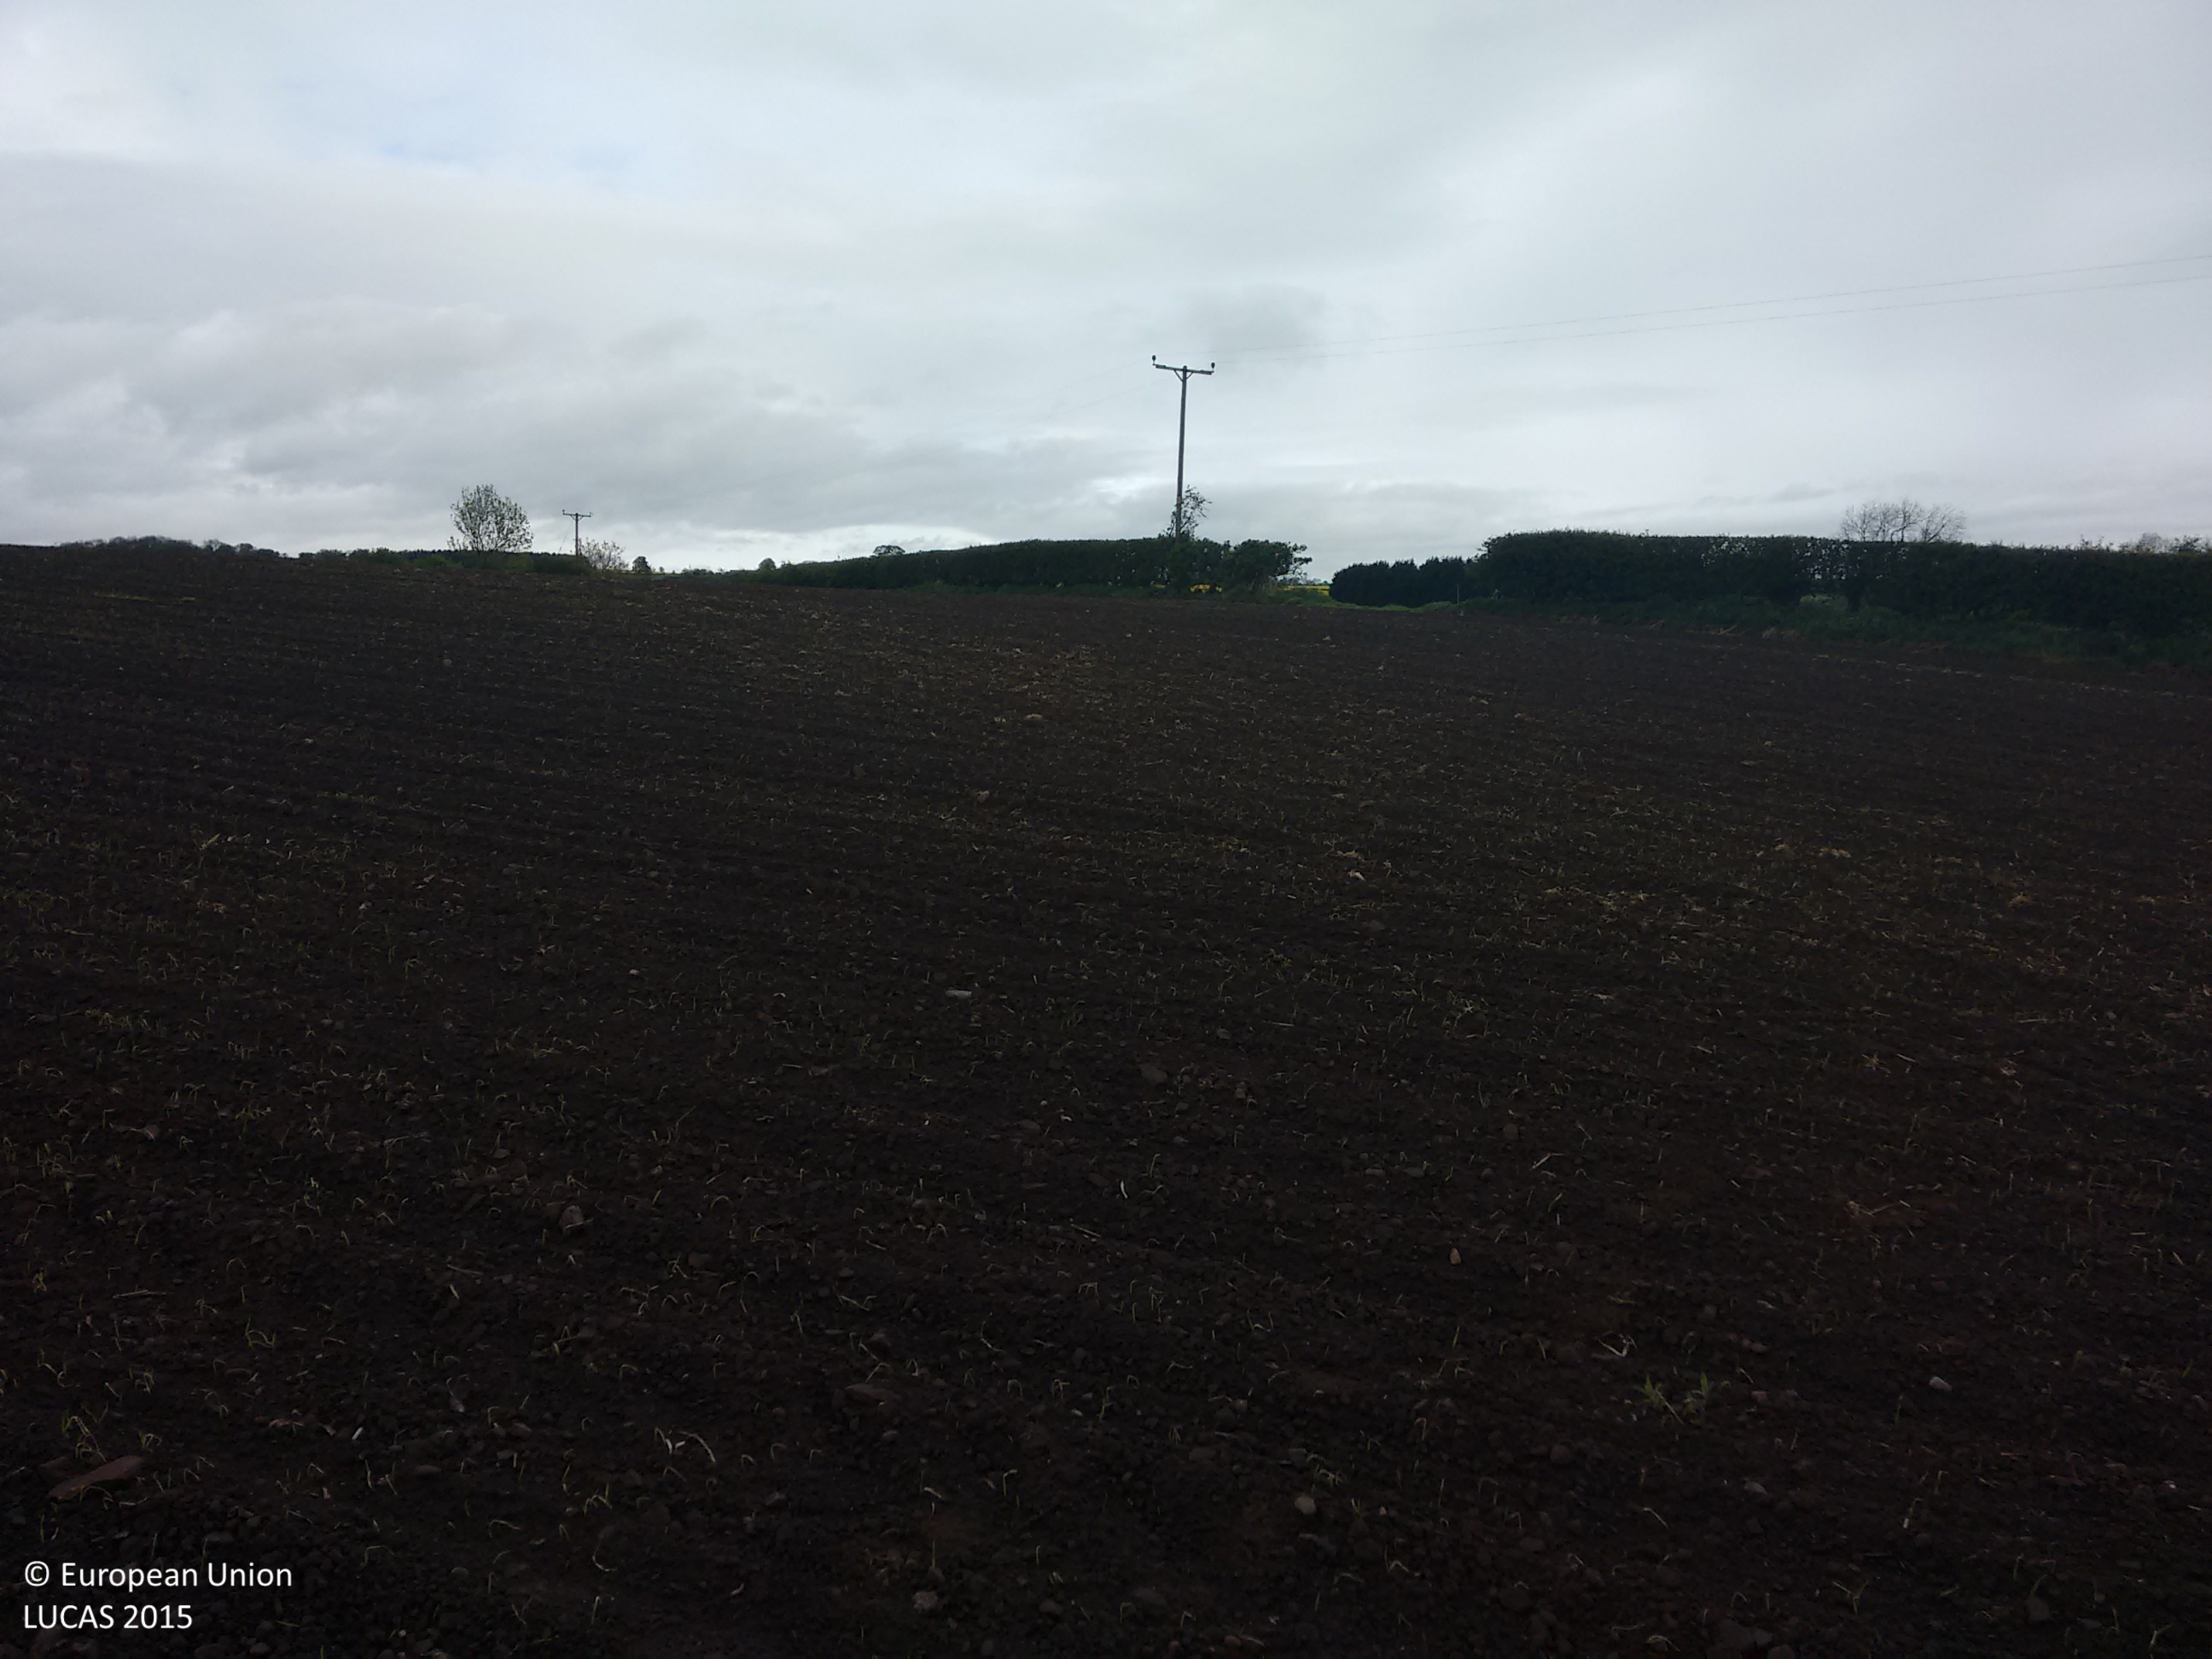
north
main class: Cropland
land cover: Common wheat
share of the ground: > 75 %
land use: Agriculture (excluding fallow land and kitchen gardens)
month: May
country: GB
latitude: 54.9697
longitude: -1.9732
